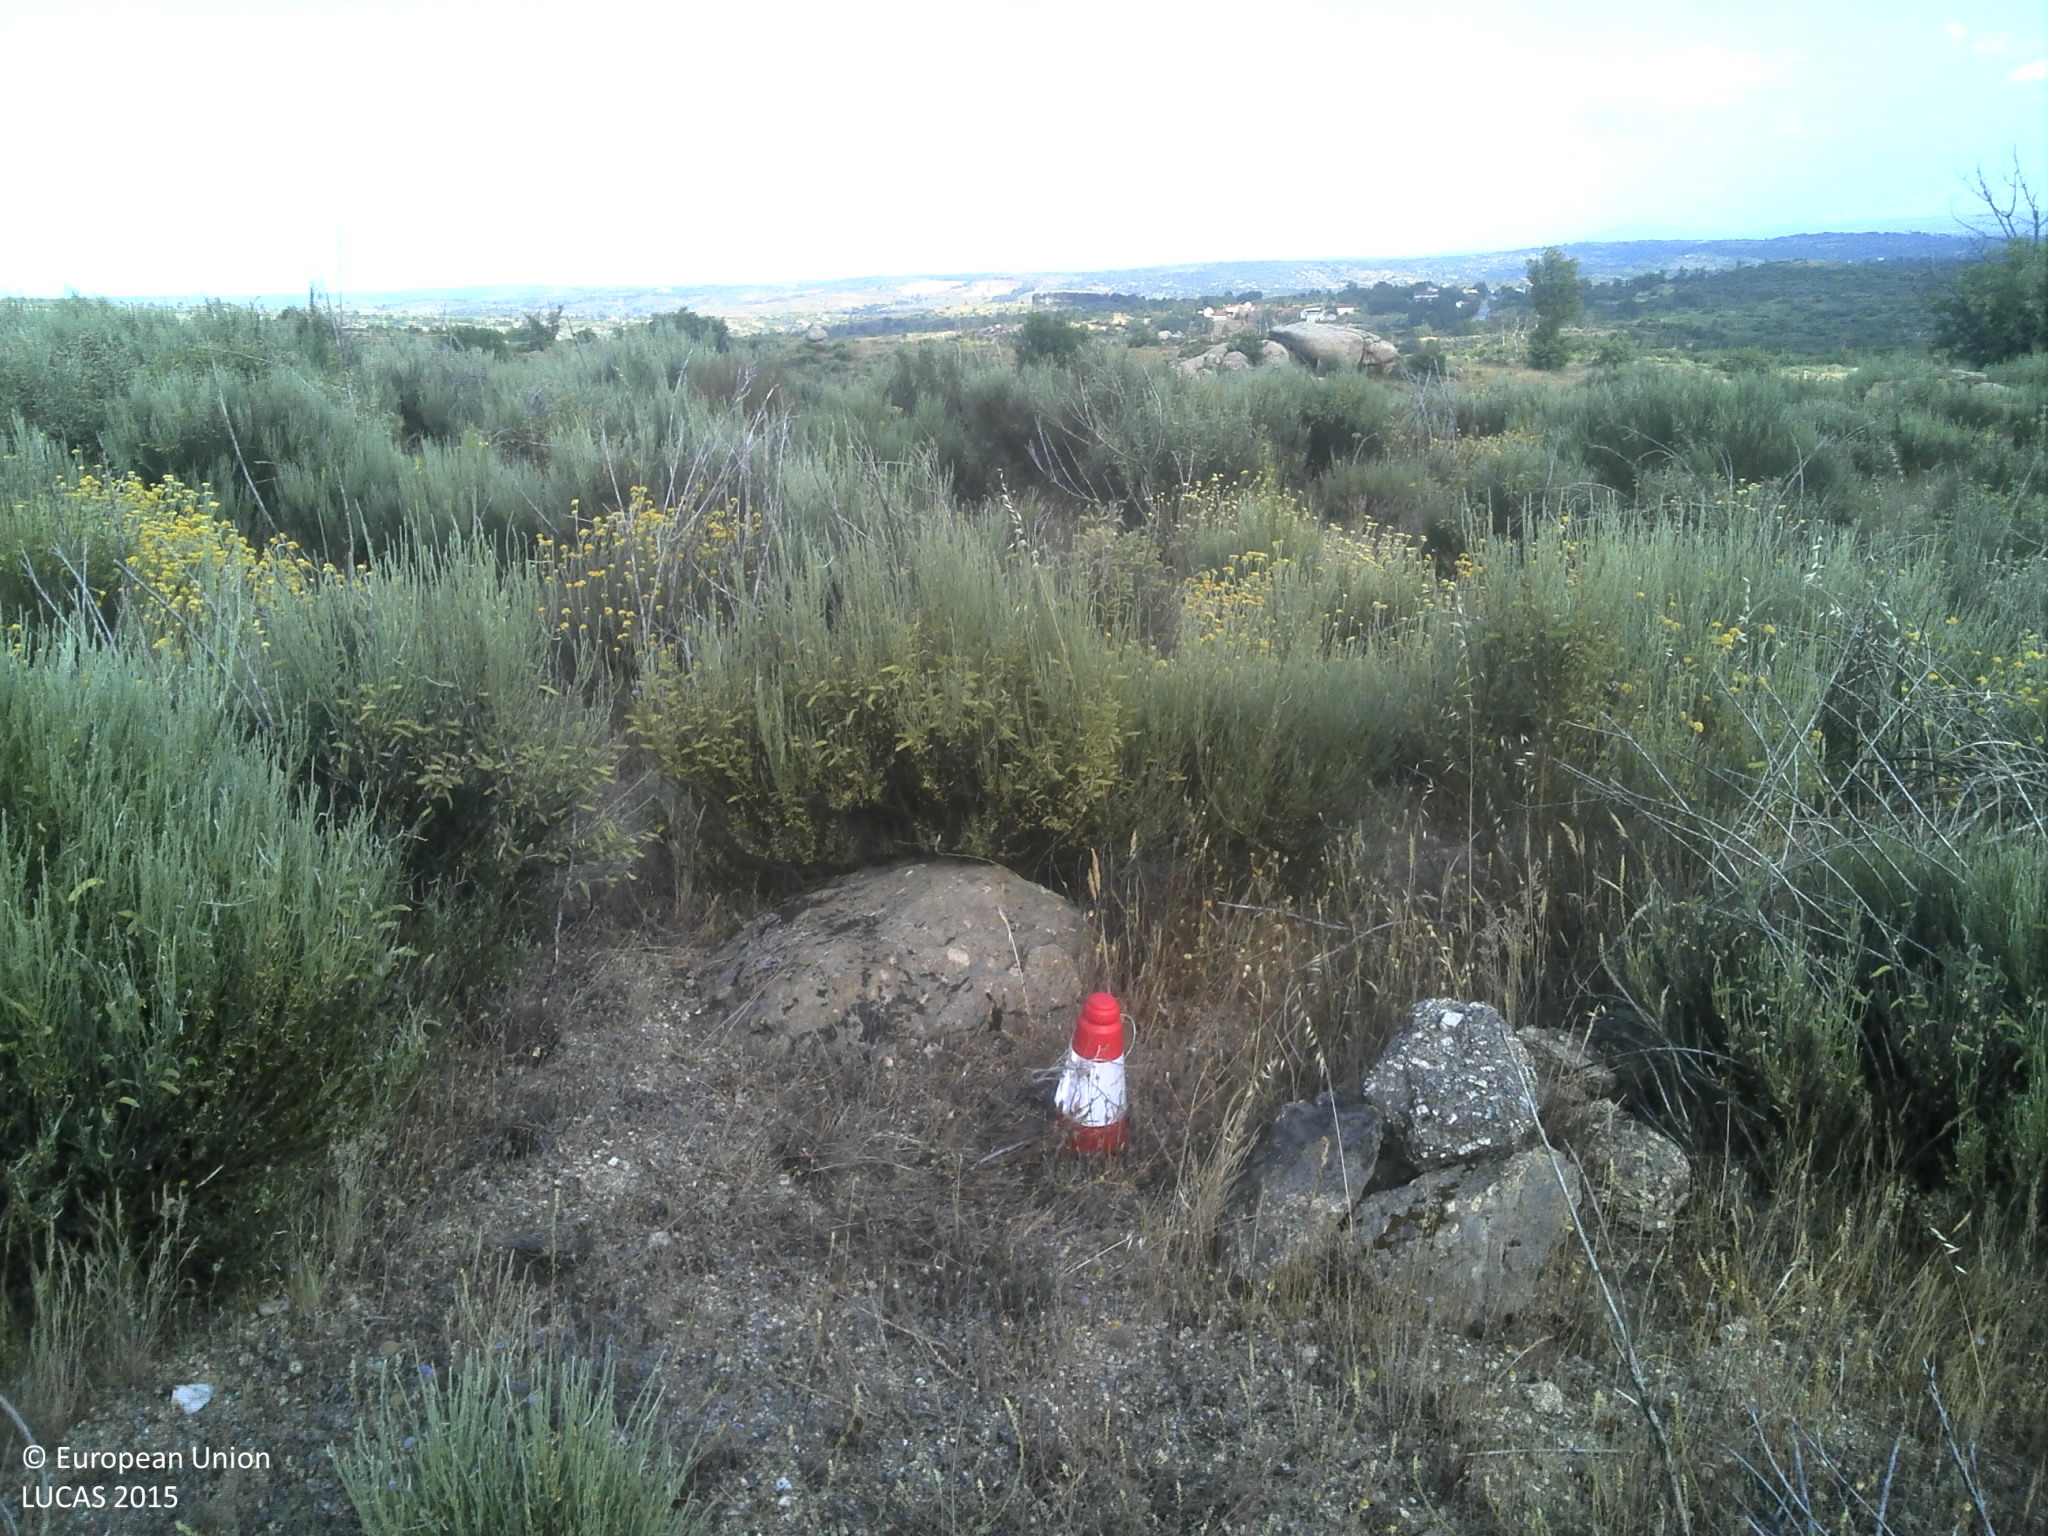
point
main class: Shrubland
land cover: Shrubland without tree cover
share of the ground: 50 - 75 %
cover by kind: shrubs 65 %, unconsolidated bare surface 15 %, herbaceous plants 10 %, consolidated bare surface 10 %
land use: Semi-natural and natural areas not in use
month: June
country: PT
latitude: 40.4948
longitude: -7.0550
